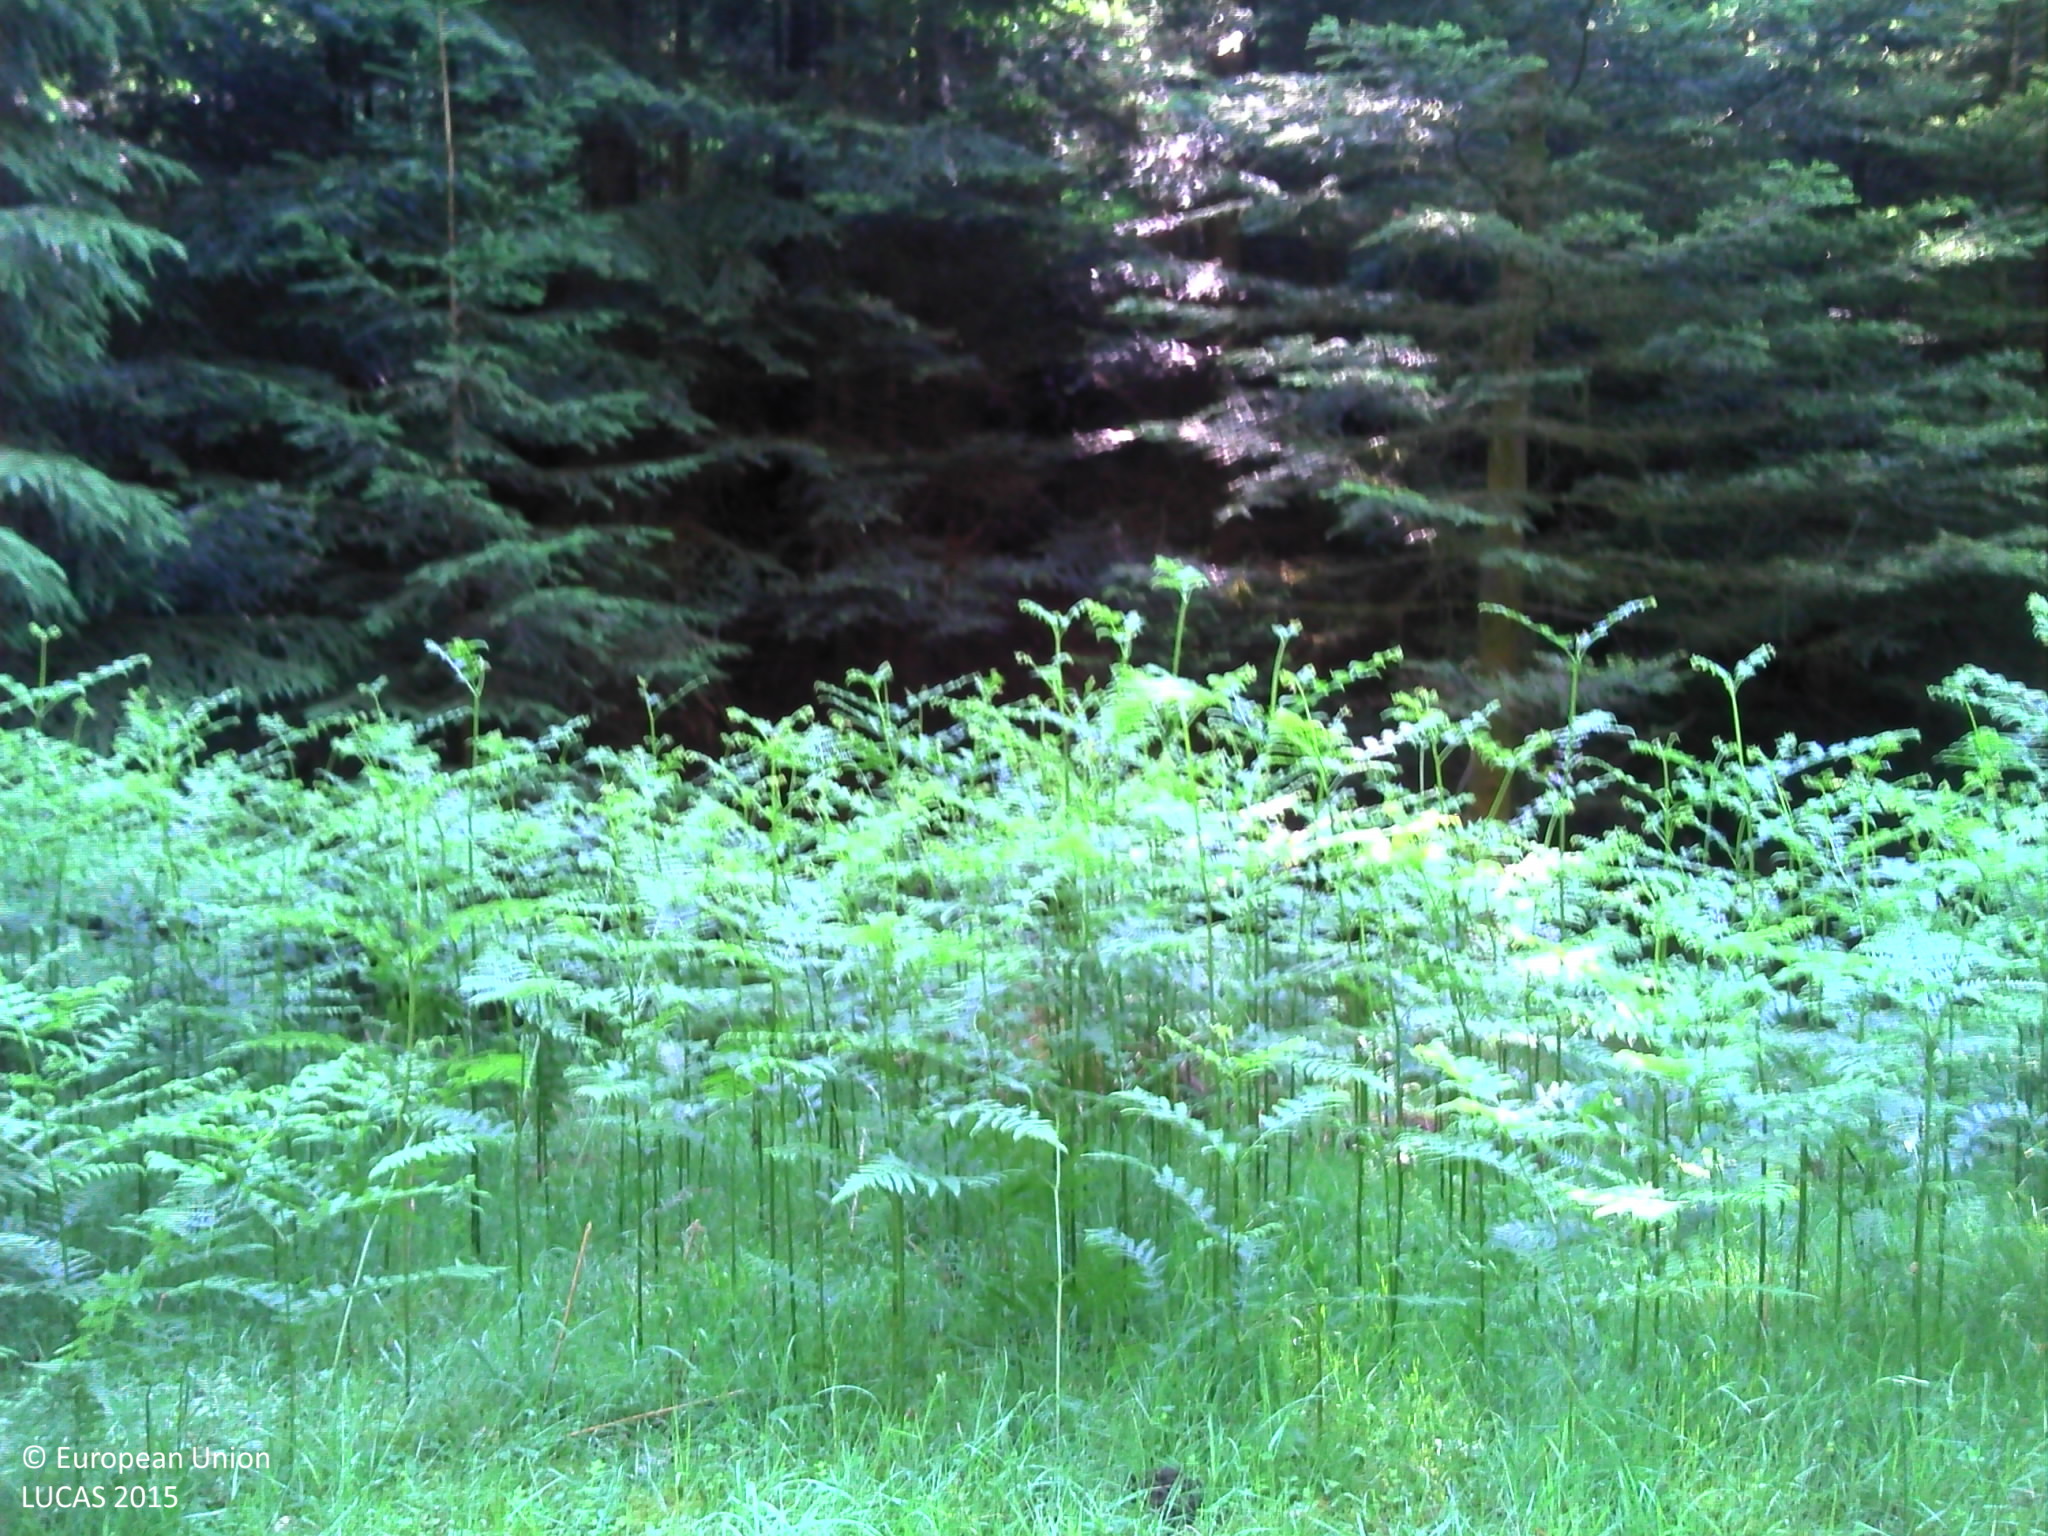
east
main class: Woodland
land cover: Spruce dominated coniferous woodland
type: alpine coniferous forest
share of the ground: > 75 %
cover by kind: coniferous forest trees 90 %, herbaceous plants 10 %
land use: Forestry
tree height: > 5 m
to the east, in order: Artificial constructions in urban areas; Grass margins; Spontaneously vegetated surfaces; Rivers and streams; Spruce dominated coniferous woodland; Tracks; Spruce dominated coniferous woodland
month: June
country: FR
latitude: 48.6759
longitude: 7.2710
